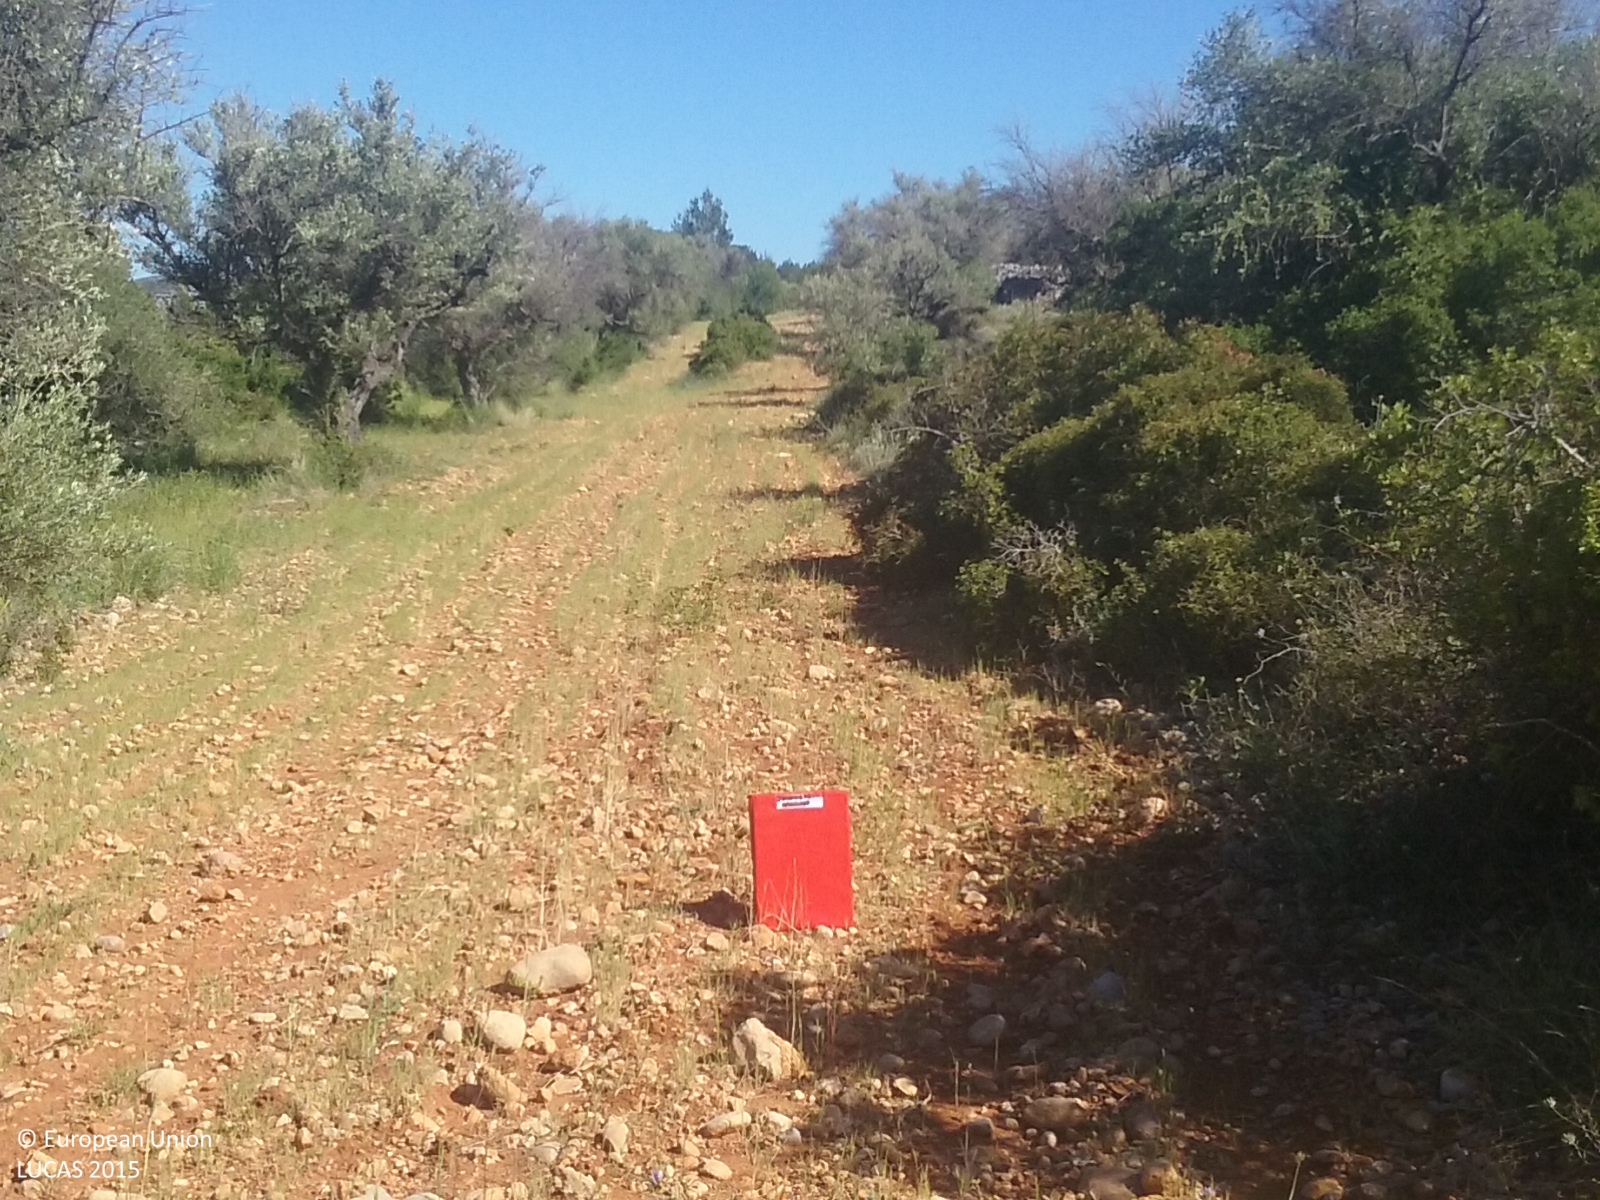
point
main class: Cropland
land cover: Olive groves
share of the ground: 25 - 50 %
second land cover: Spontaneously vegetated surfaces
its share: 10 - 25 %
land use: Agriculture (excluding fallow land and kitchen gardens)
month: May
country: ES
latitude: 40.3797
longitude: 0.2319
